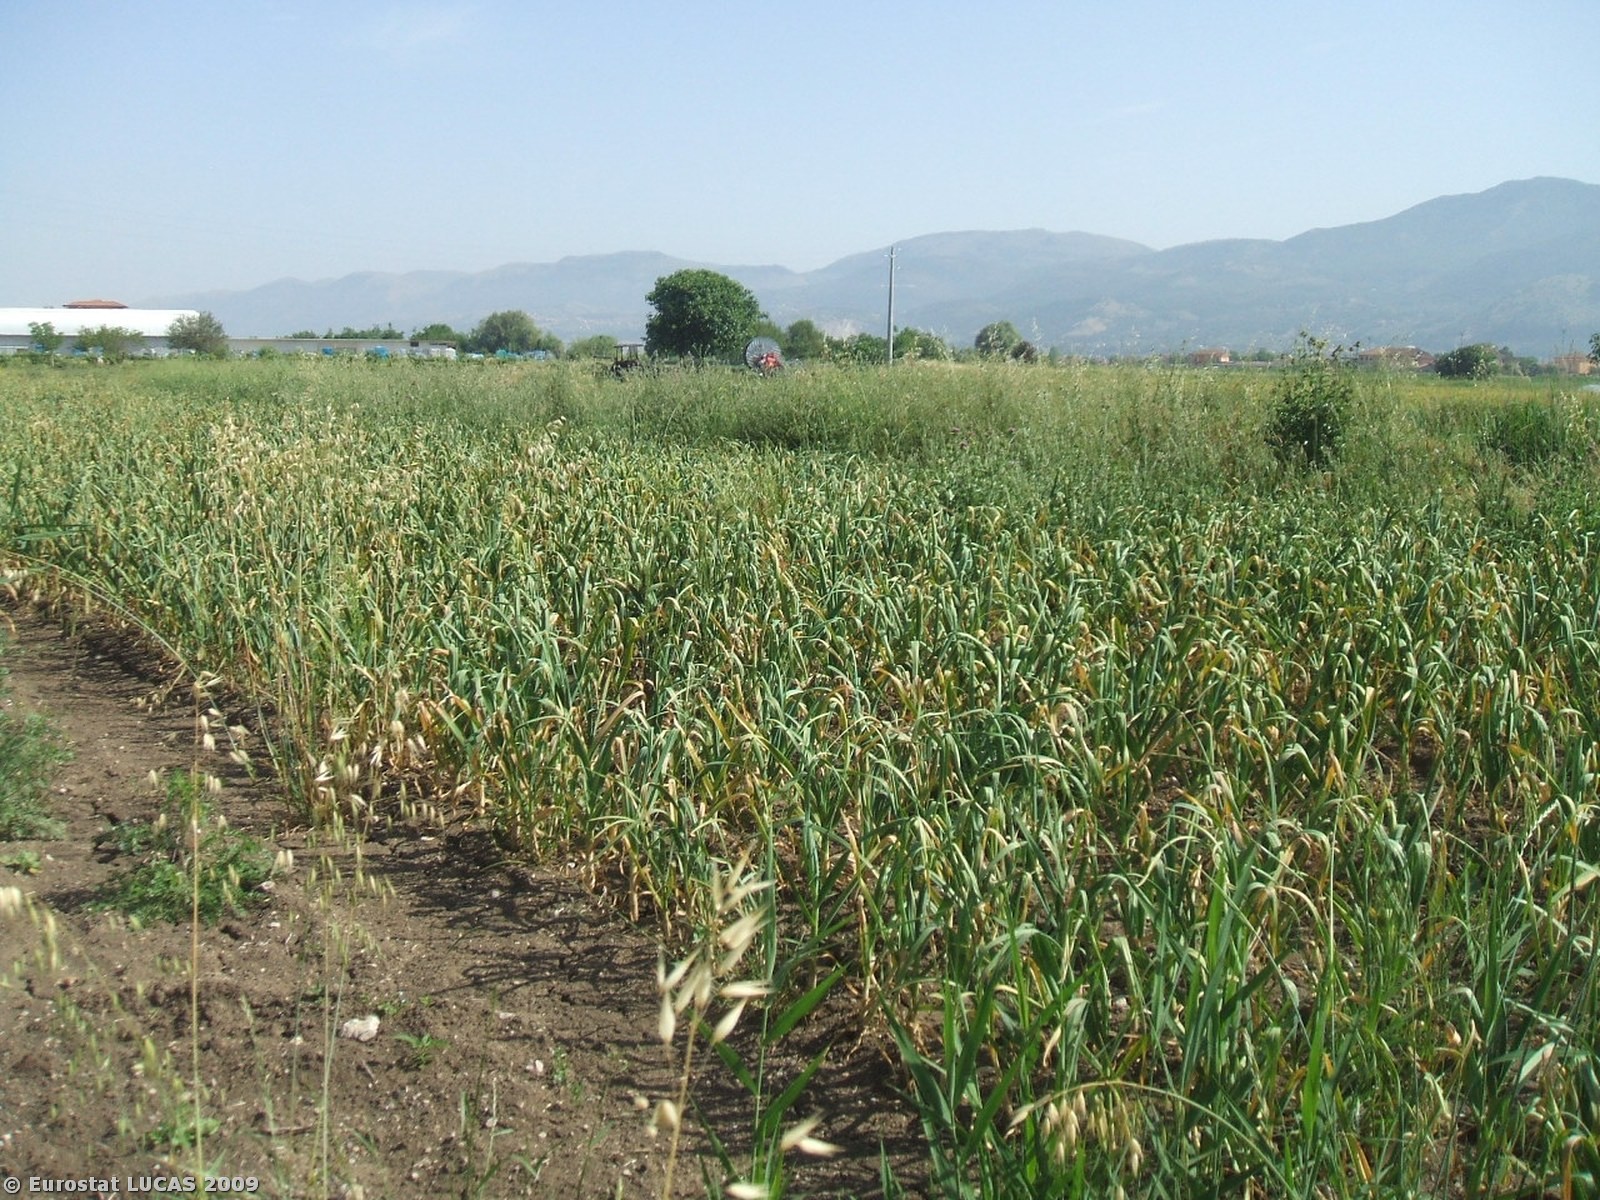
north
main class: Cropland
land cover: Other fresh vegetables
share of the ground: > 75 %
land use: Agriculture (excluding fallow land and kitchen gardens)
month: May
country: IT
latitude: 40.3823
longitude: 15.5484
